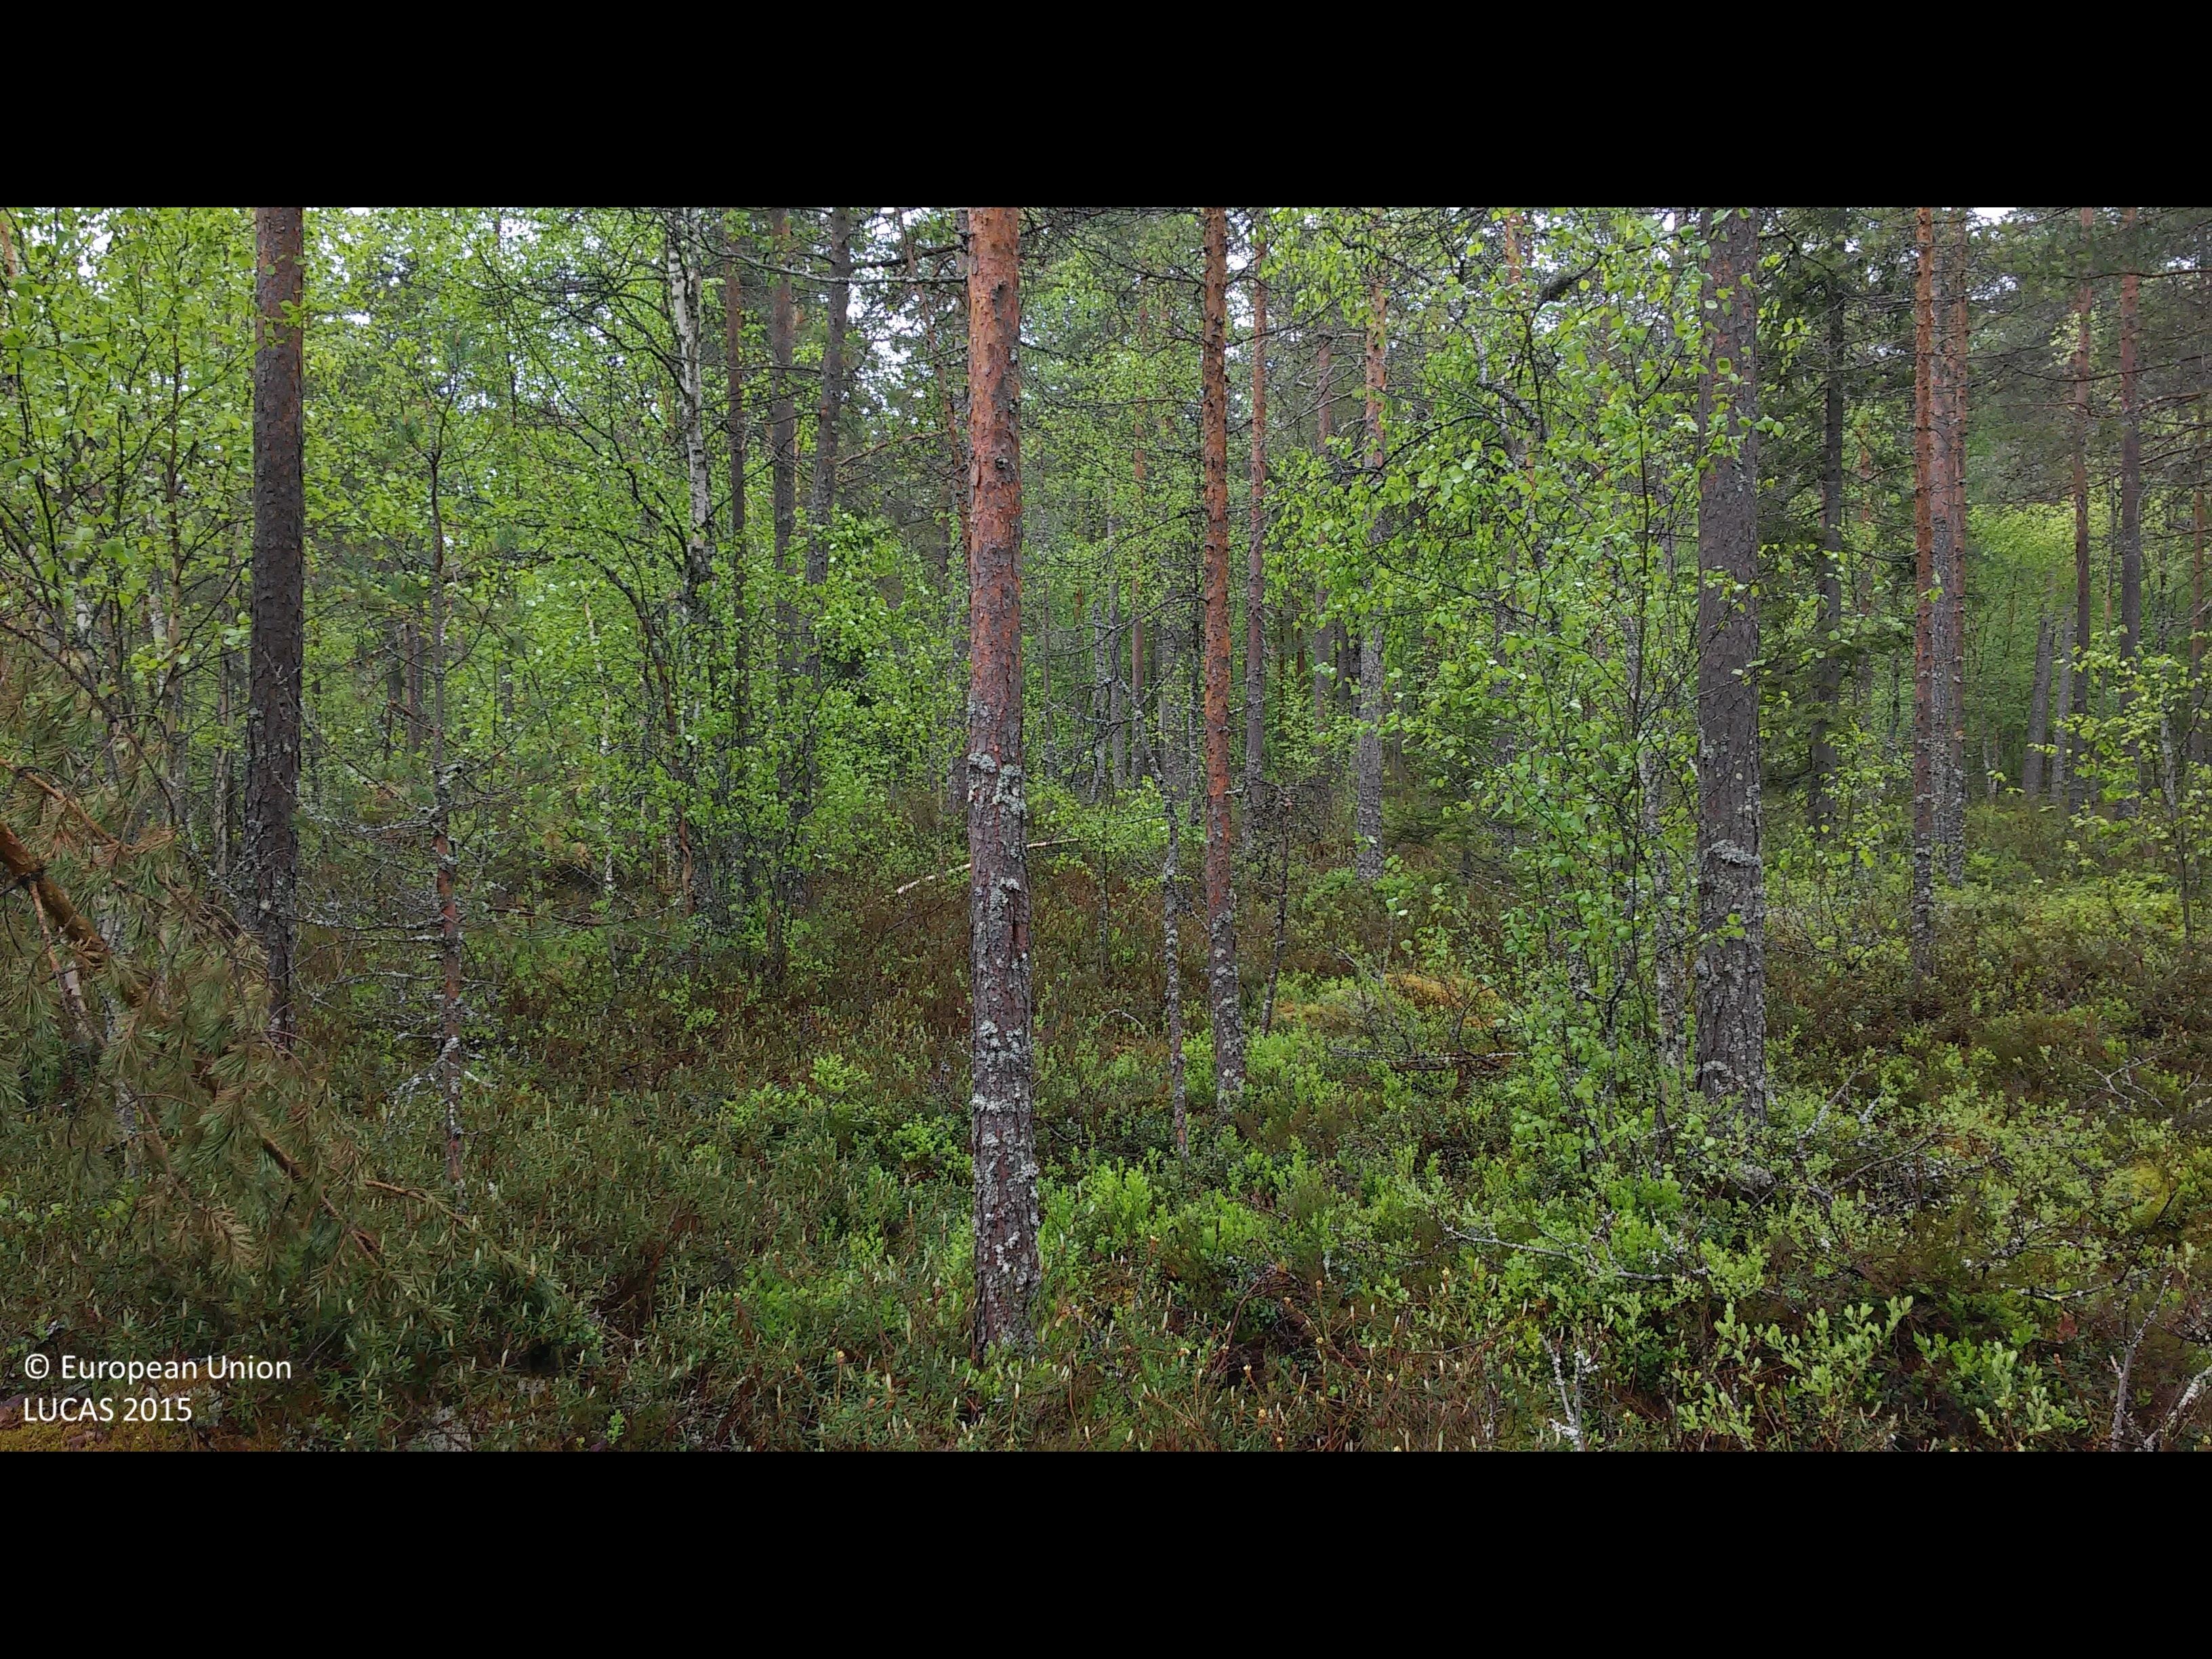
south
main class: Woodland
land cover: Pine dominated mixed woodland
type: boreal forest
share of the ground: > 75 %
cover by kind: coniferous forest trees 70 %, broadleaved forest trees 25 %, lichens and mosses 5 %
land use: Forestry
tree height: > 5 m
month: June
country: FI
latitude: 63.7590
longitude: 24.1595
